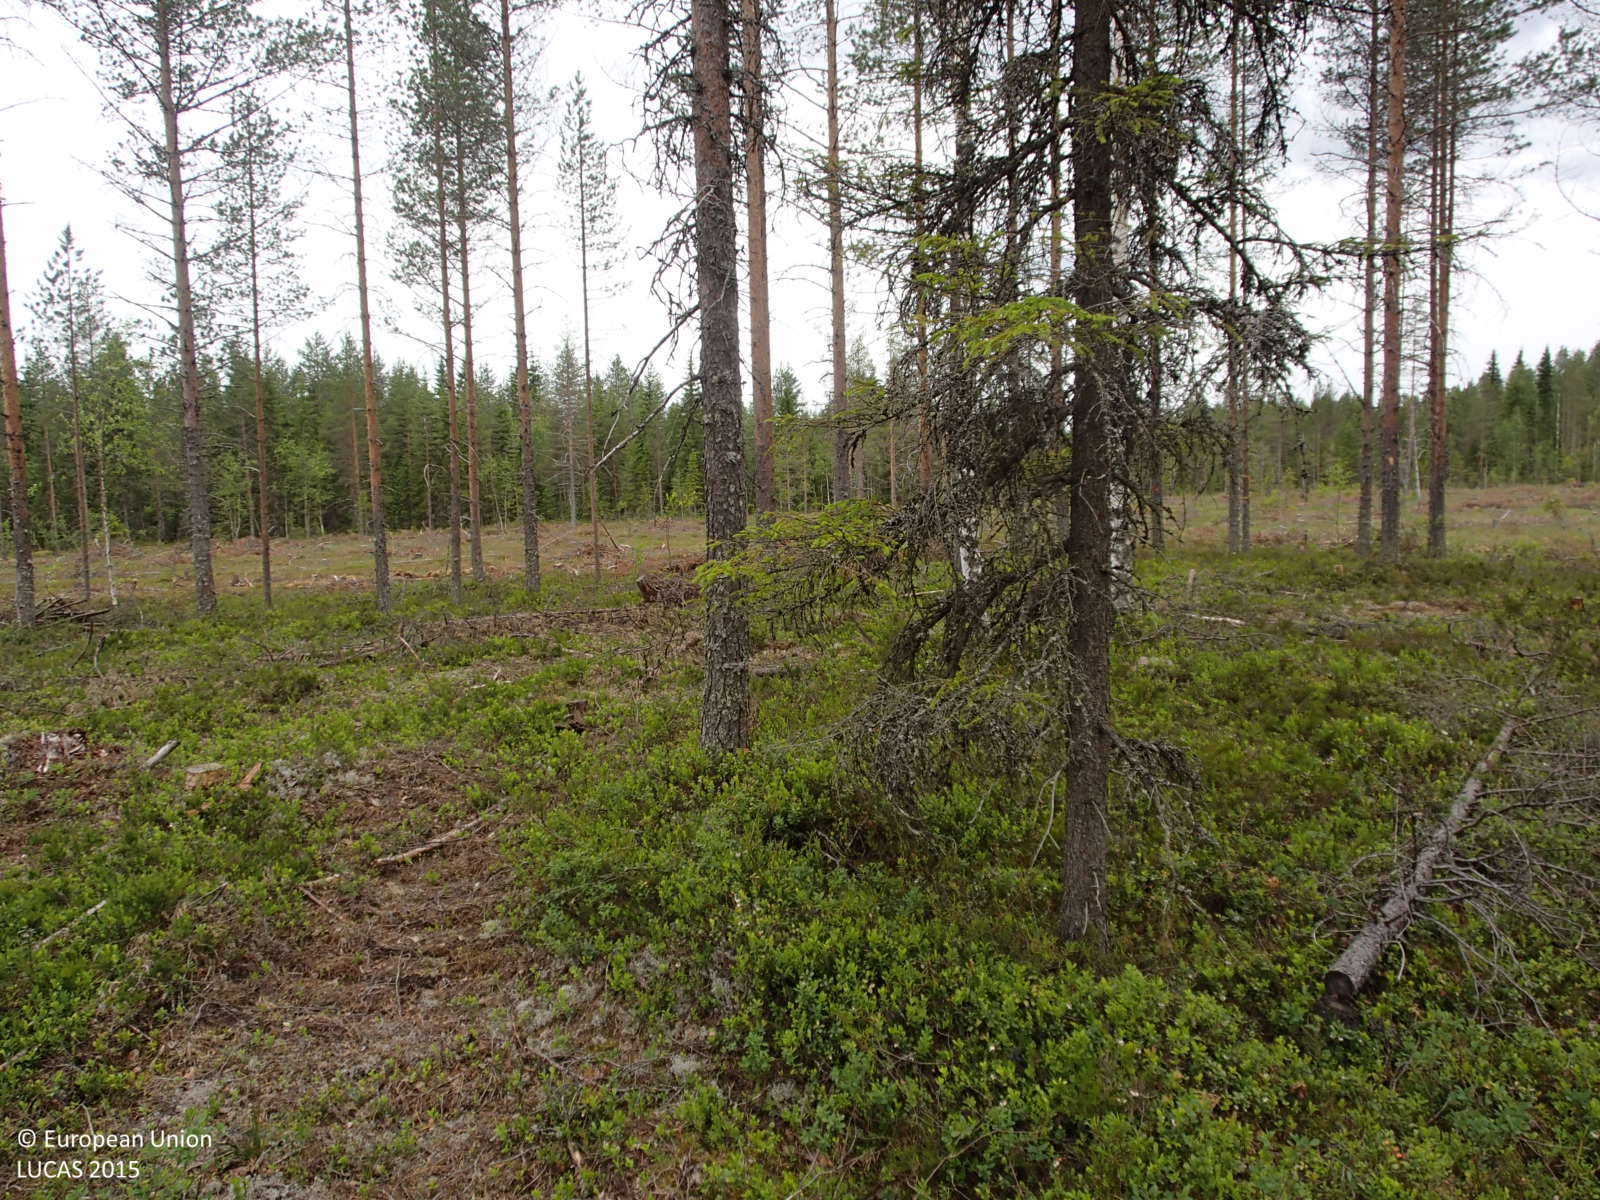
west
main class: Woodland
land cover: Pine dominated coniferous woodland
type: boreal forest
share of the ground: 50 - 75 %
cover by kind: coniferous forest trees 50 %, shrubs 35 %, lichens and mosses 10 %, broadleaved forest trees 5 %
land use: Forestry
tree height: > 5 m
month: July
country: FI
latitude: 63.9600
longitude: 27.1044
